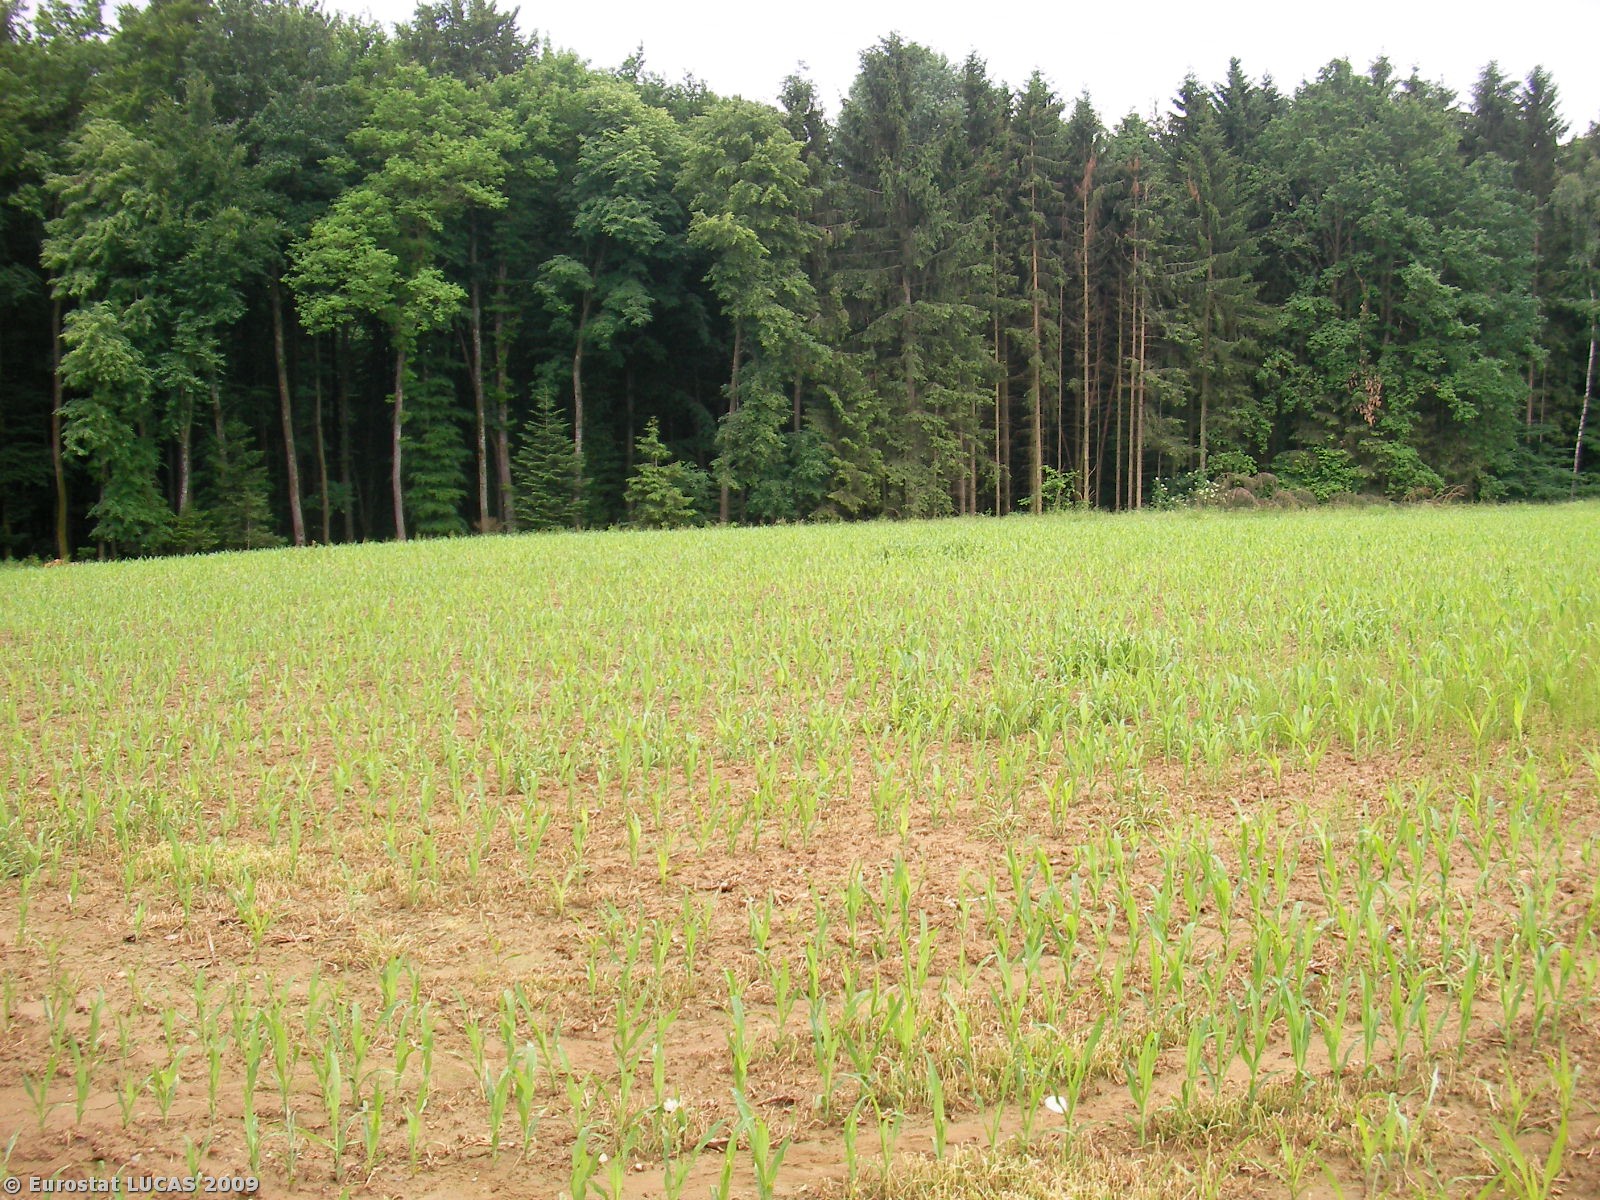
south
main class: Cropland
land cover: Maize
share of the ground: 10 - 25 %
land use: Agriculture (excluding fallow land and kitchen gardens)
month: June
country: AT
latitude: 47.1539
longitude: 15.7379
